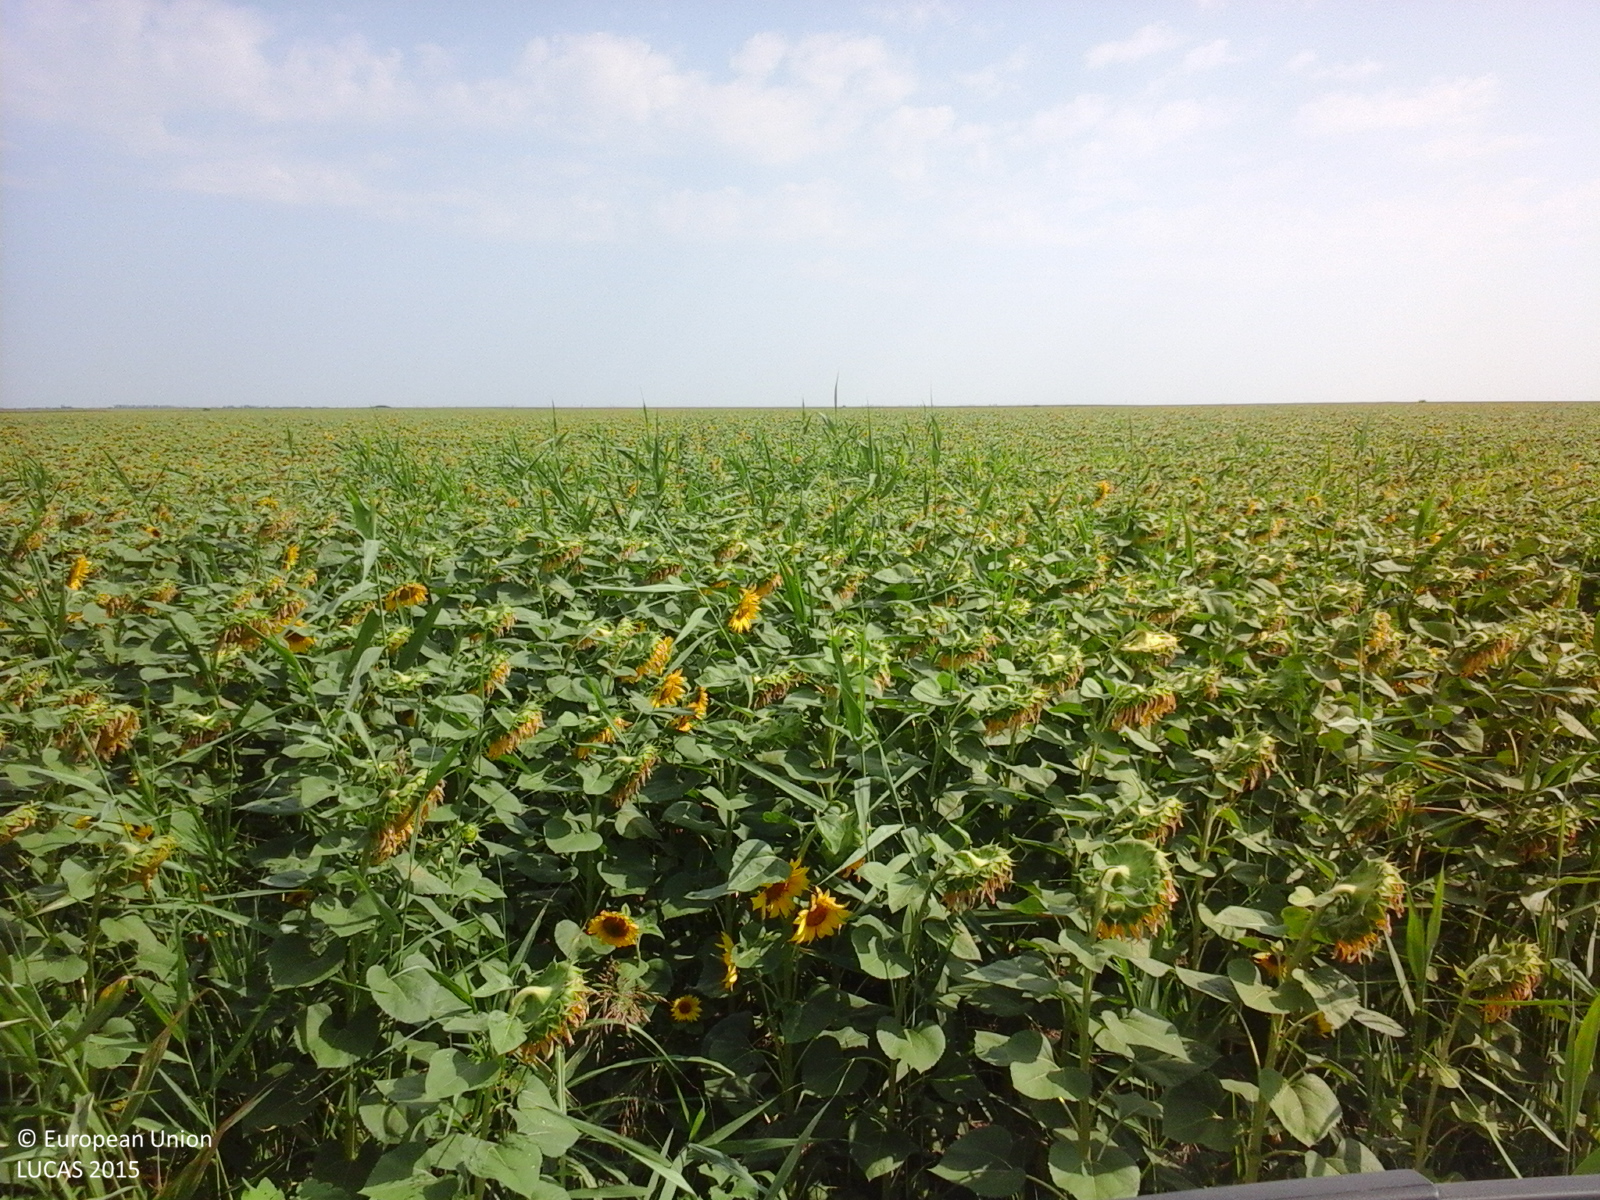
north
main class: Cropland
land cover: Sunflower
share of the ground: > 75 %
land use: Agriculture (excluding fallow land and kitchen gardens)
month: July
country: RO
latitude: 44.6813
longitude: 27.2321
